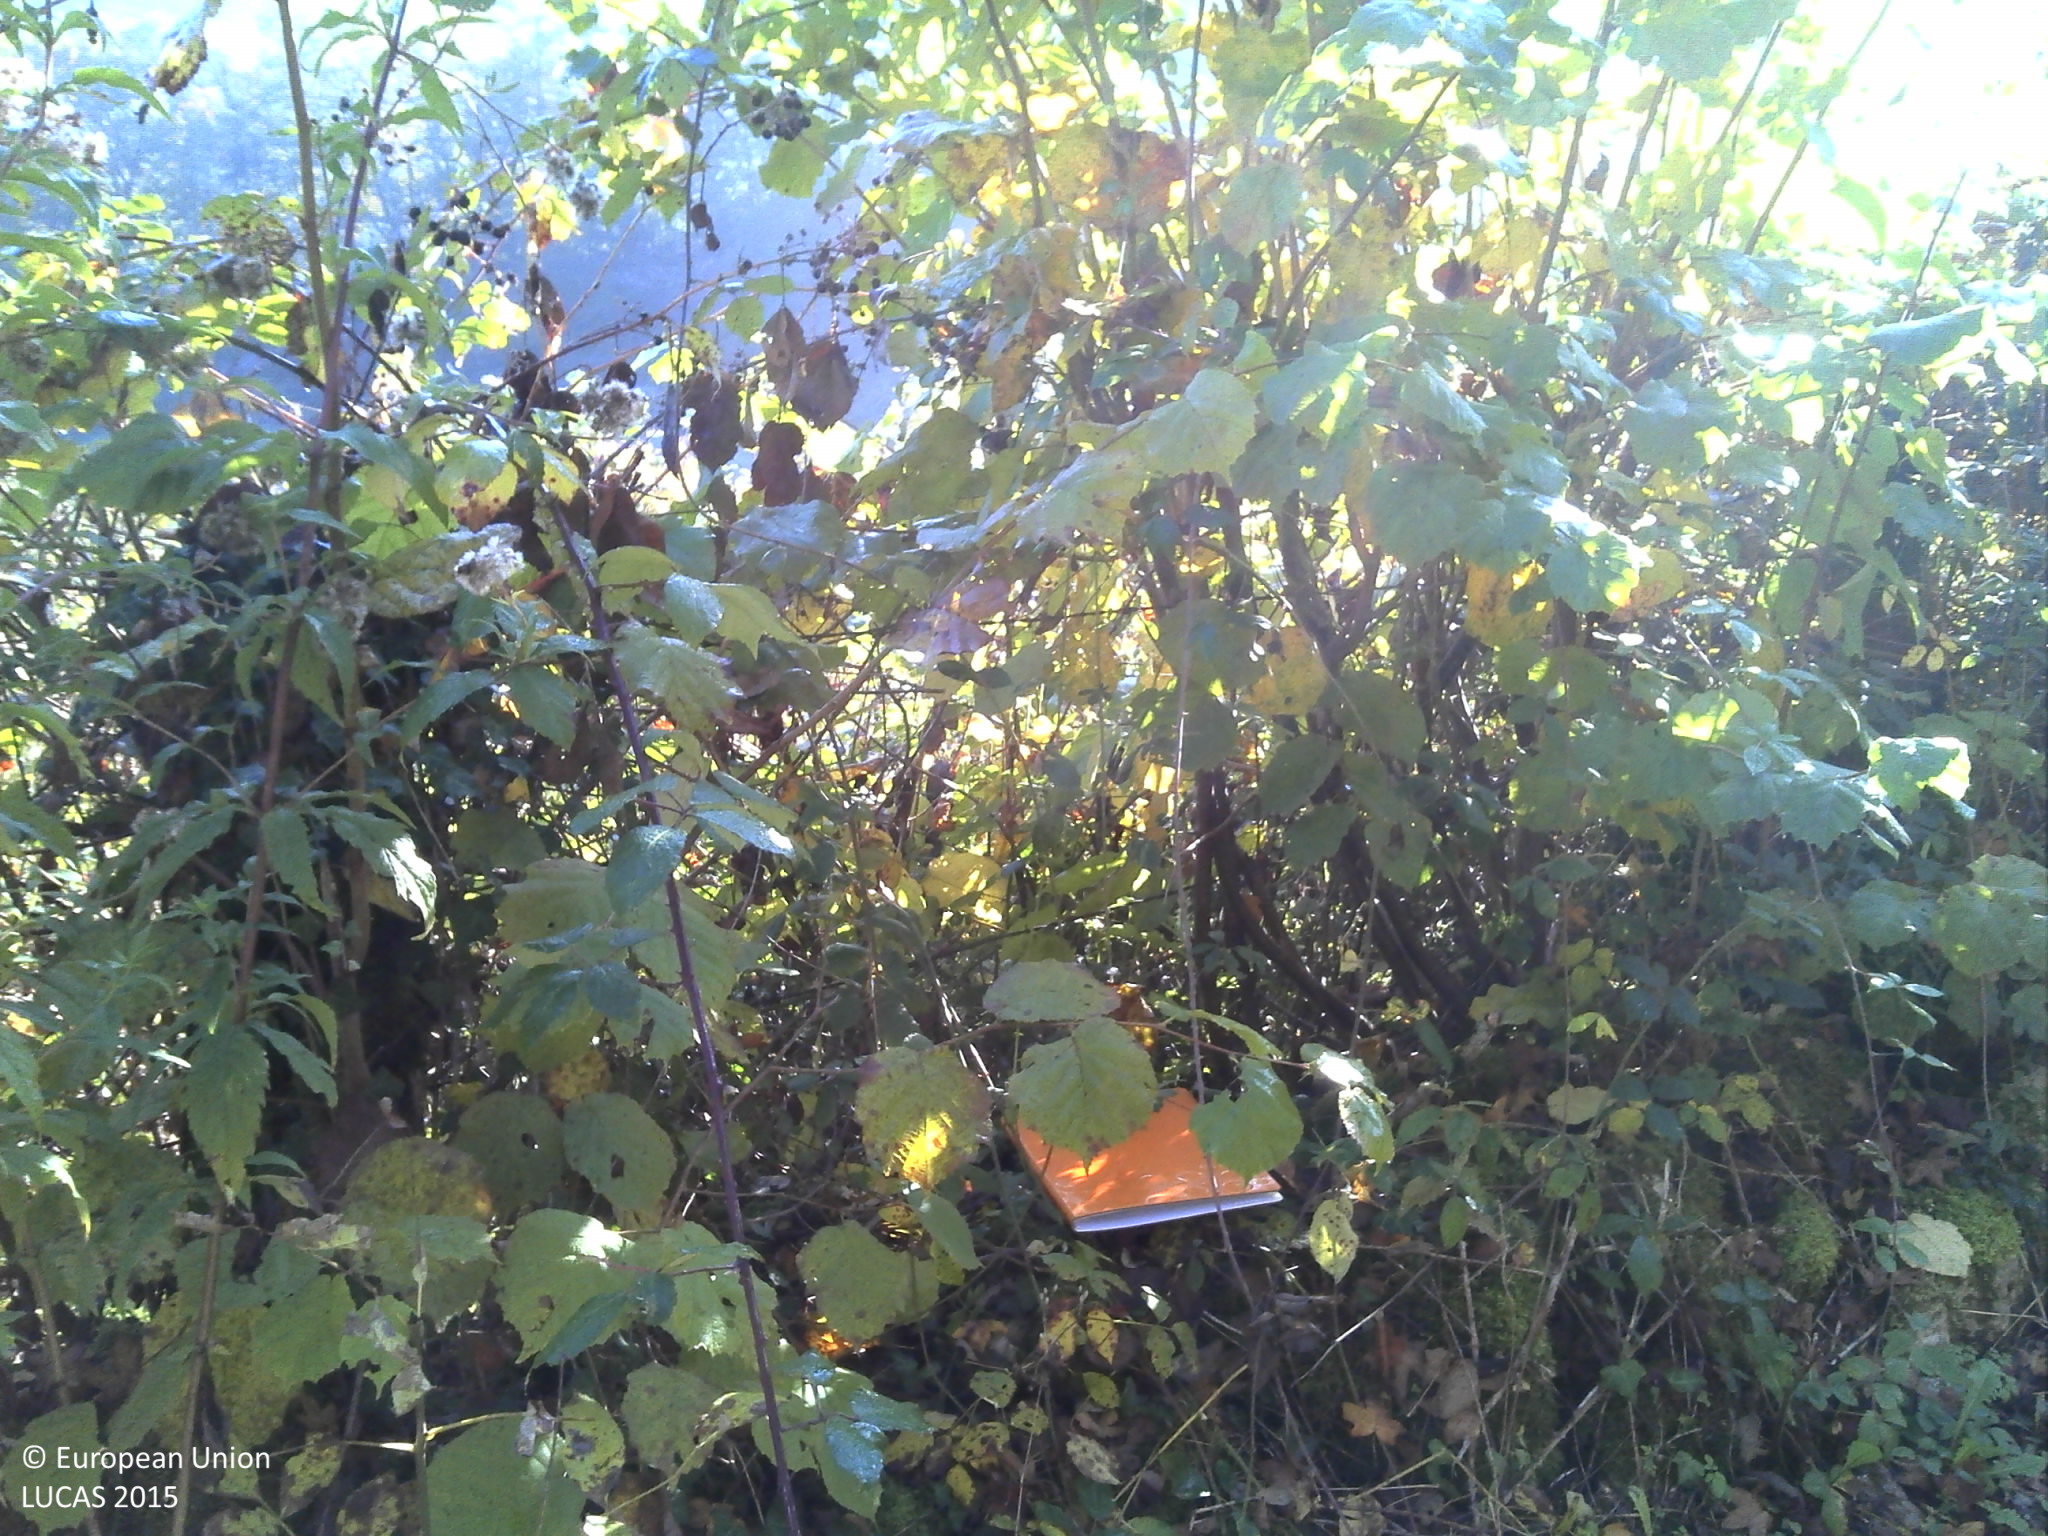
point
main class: Shrubland
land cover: Shrubland with sparse tree cover
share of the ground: > 75 %
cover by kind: shrubs 95 %, broadleaved forest trees 5 %
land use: Semi-natural and natural areas not in use
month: October
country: FR
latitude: 45.9286
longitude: 5.4257
